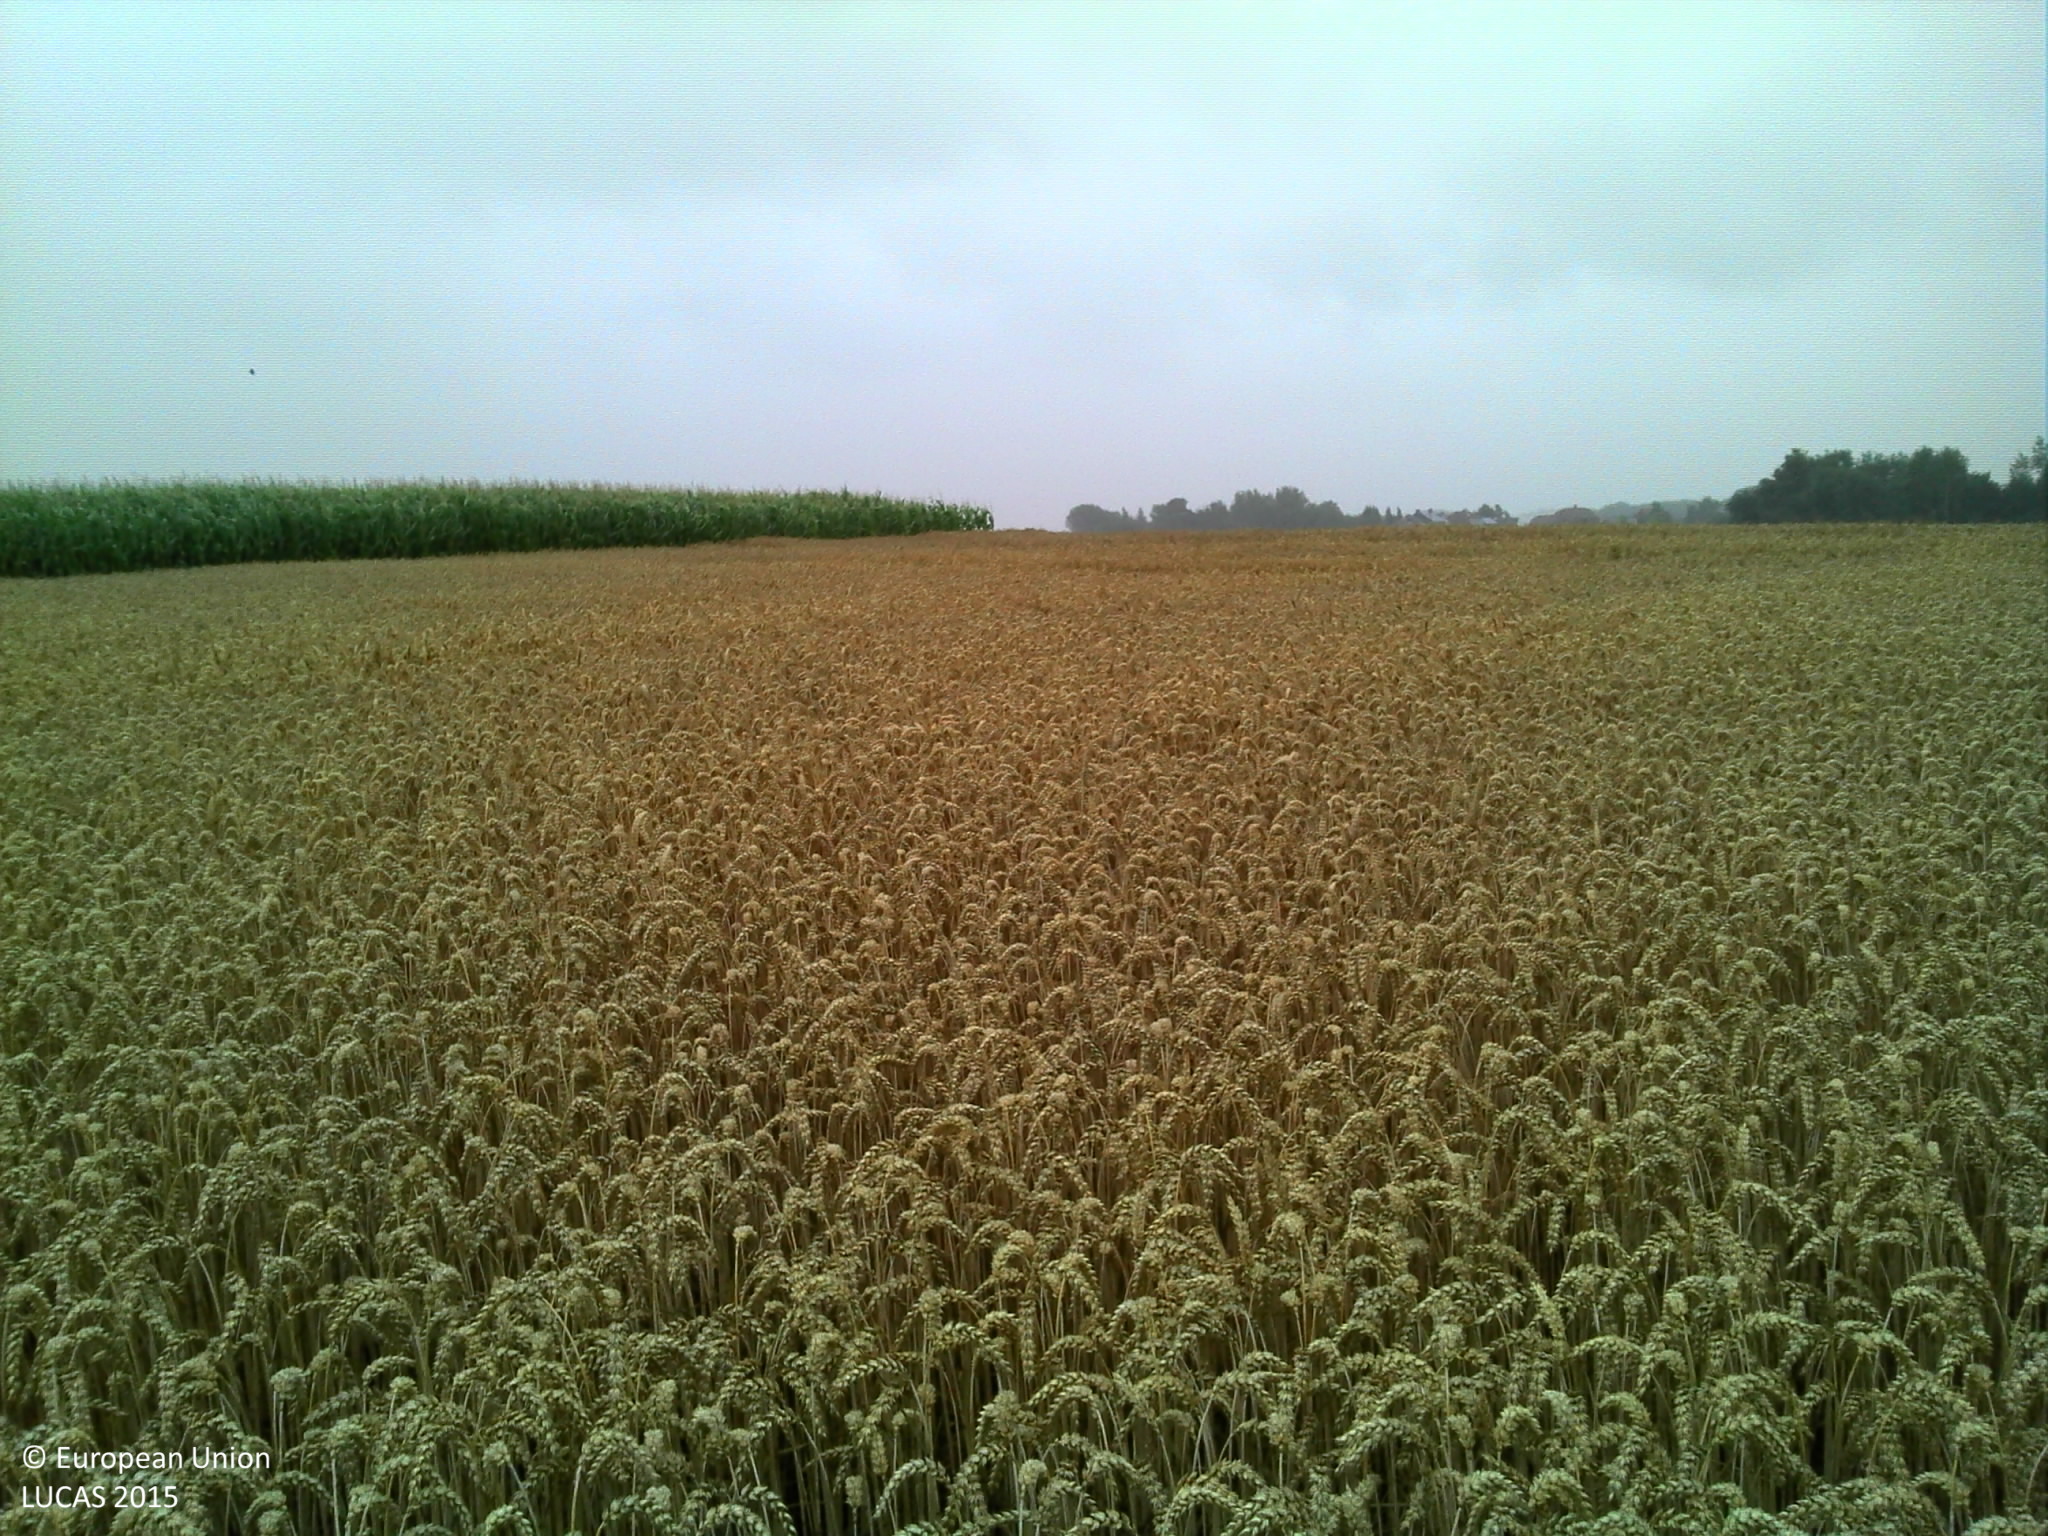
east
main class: Cropland
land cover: Common wheat
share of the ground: > 75 %
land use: Agriculture (excluding fallow land and kitchen gardens)
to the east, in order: Common wheat; Maize; Grass margins; Tracks; Grass margins; Common wheat
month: July
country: BE
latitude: 50.5233
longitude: 4.5655
